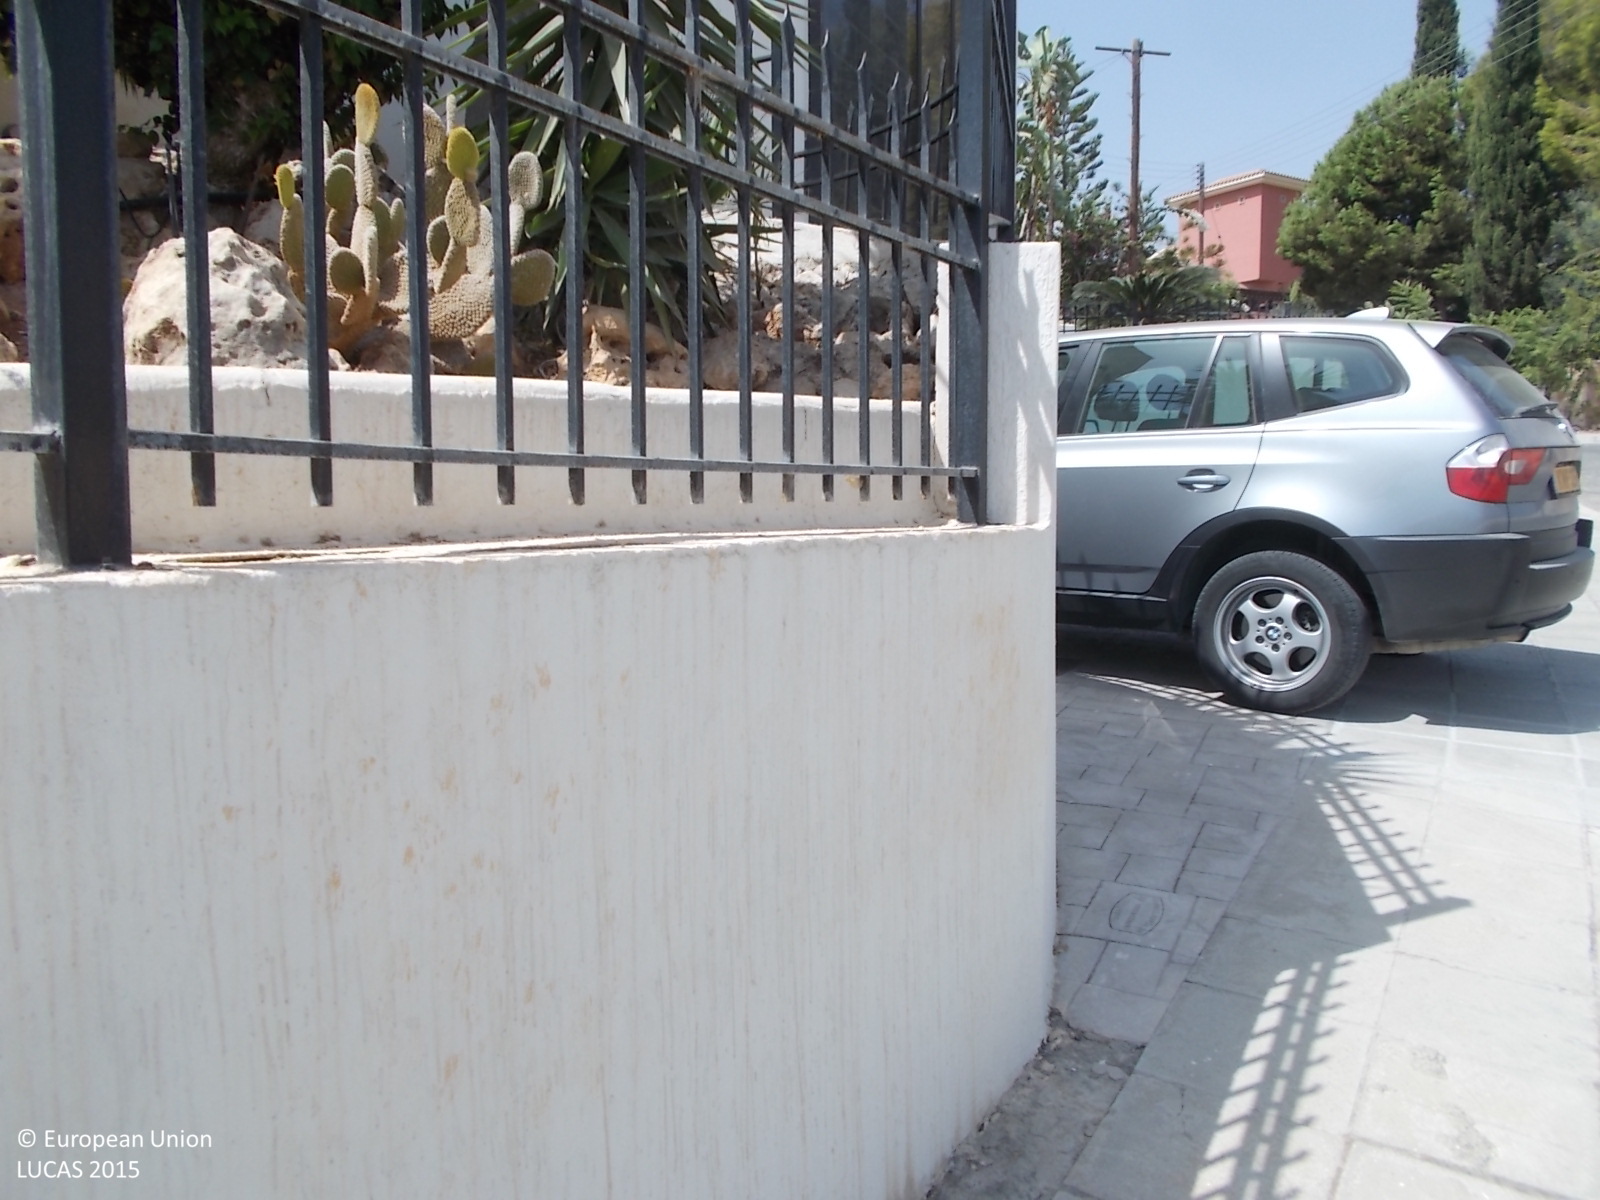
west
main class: Woodland
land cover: Broadleaved woodland
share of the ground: 50 - 75 %
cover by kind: broadleaved forest trees 70 %, unconsolidated bare surface 20 %, consolidated bare surface 10 %
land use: Residential
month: April
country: CY
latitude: 34.7101
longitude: 33.1078
